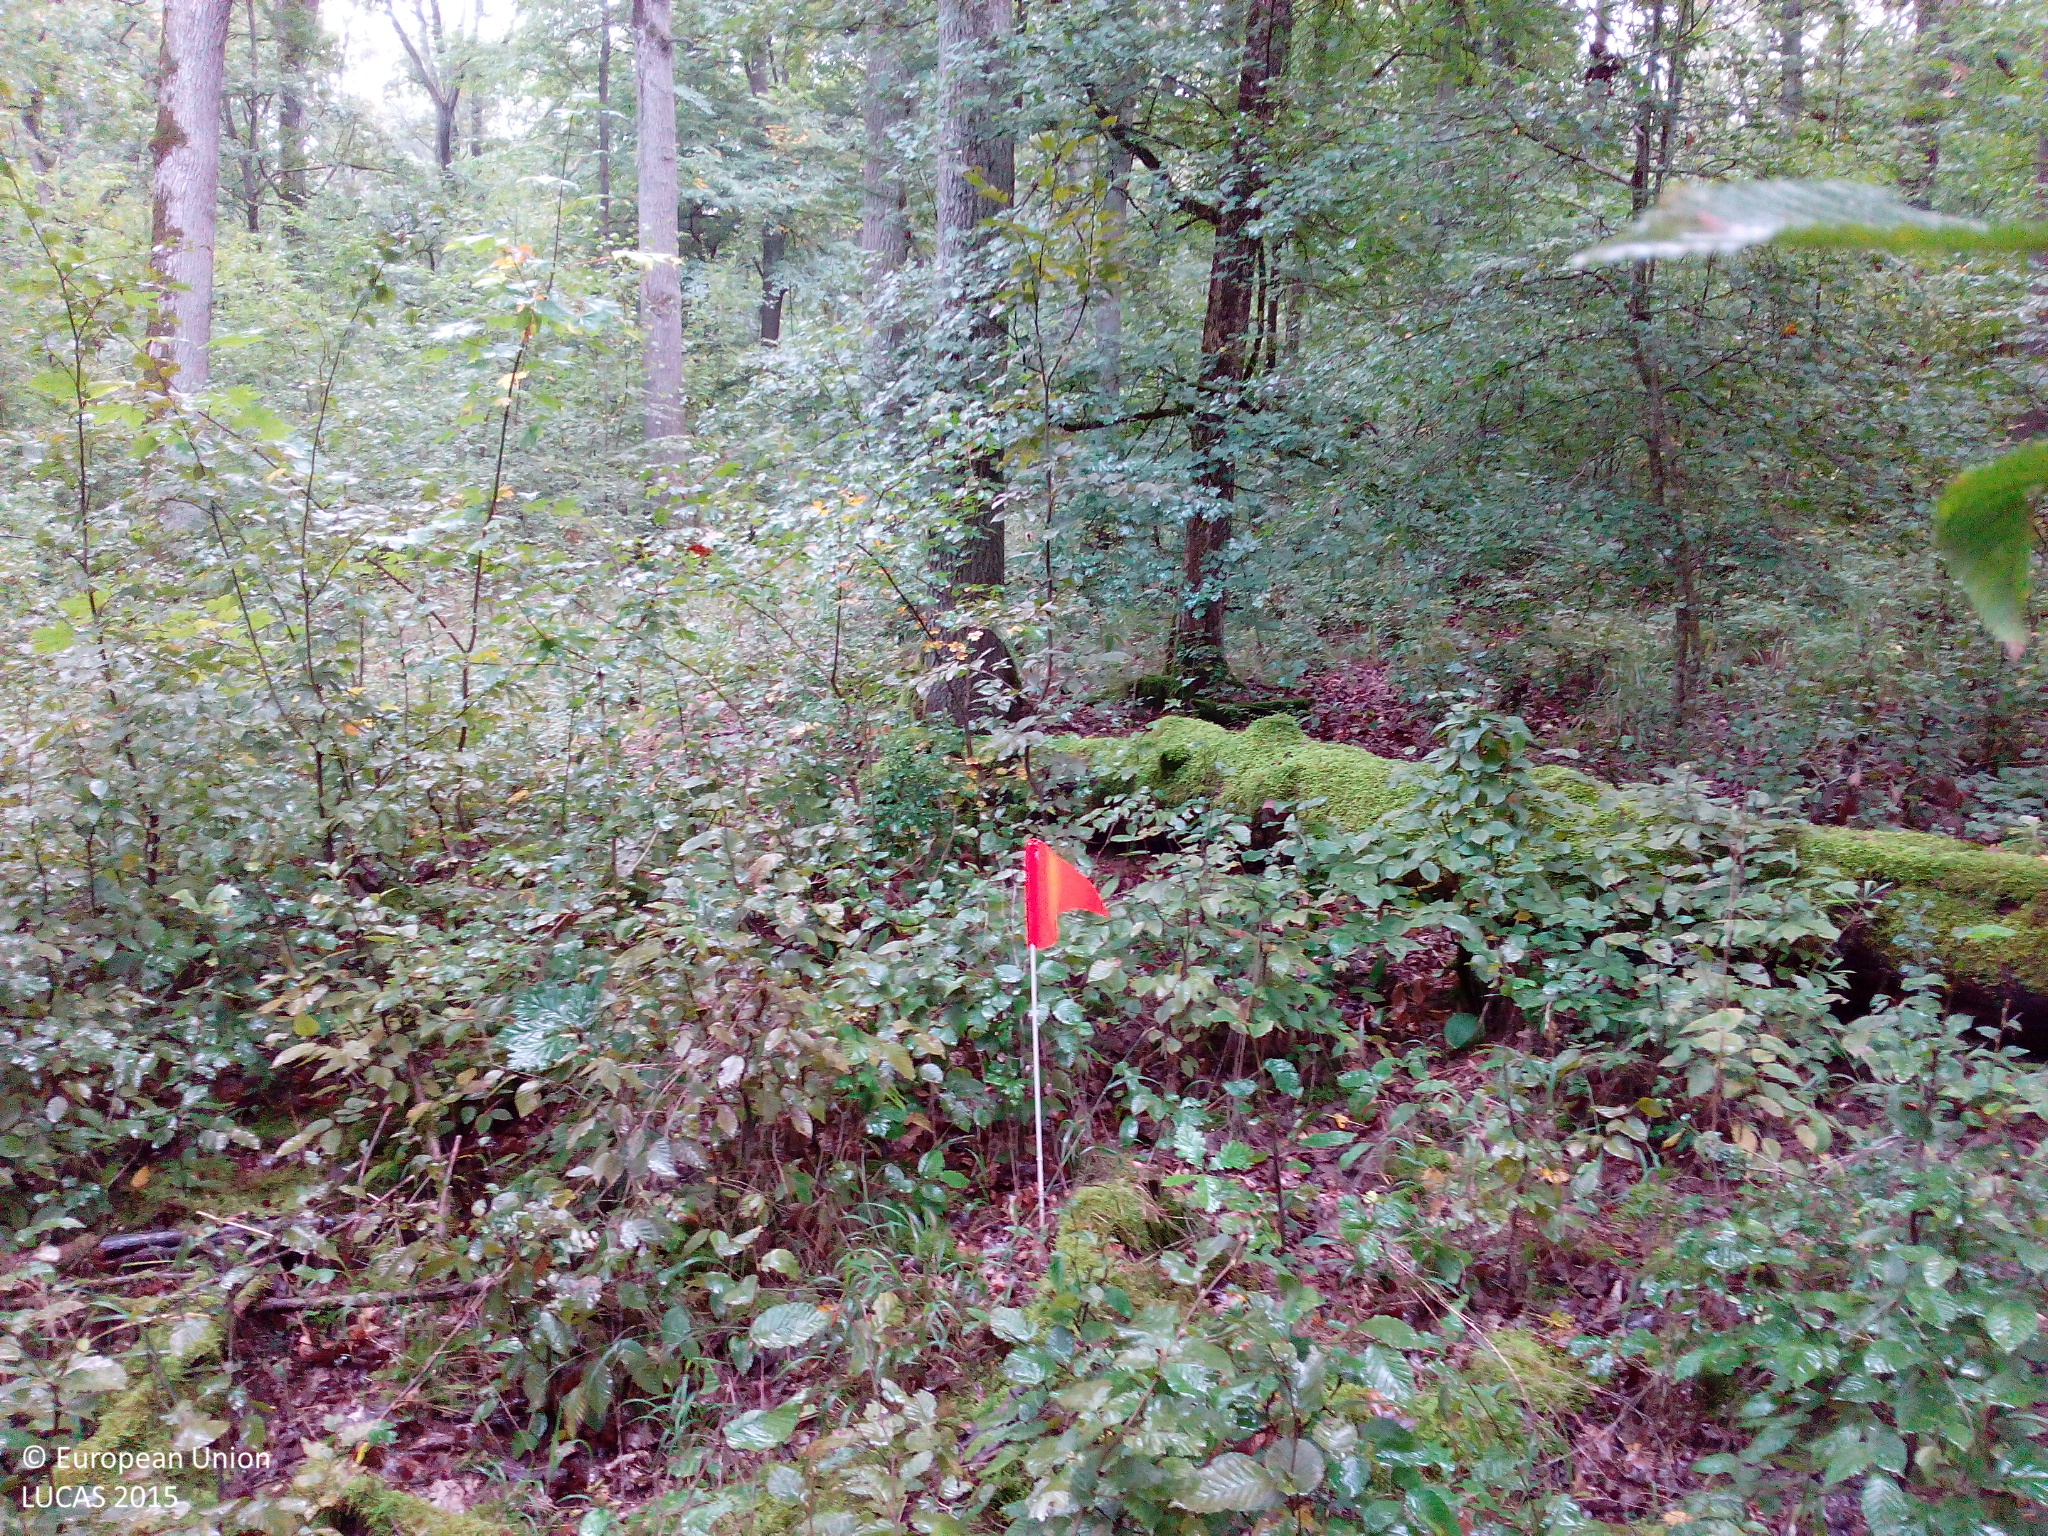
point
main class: Woodland
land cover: Broadleaved woodland
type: acidophilous oak and oak-birch forest
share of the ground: > 75 %
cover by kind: broadleaved forest trees 95 %, shrubs 5 %
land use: Forestry
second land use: Amenities, museums, leisure
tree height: > 5 m
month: September
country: DE
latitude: 49.9504
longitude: 9.9582
